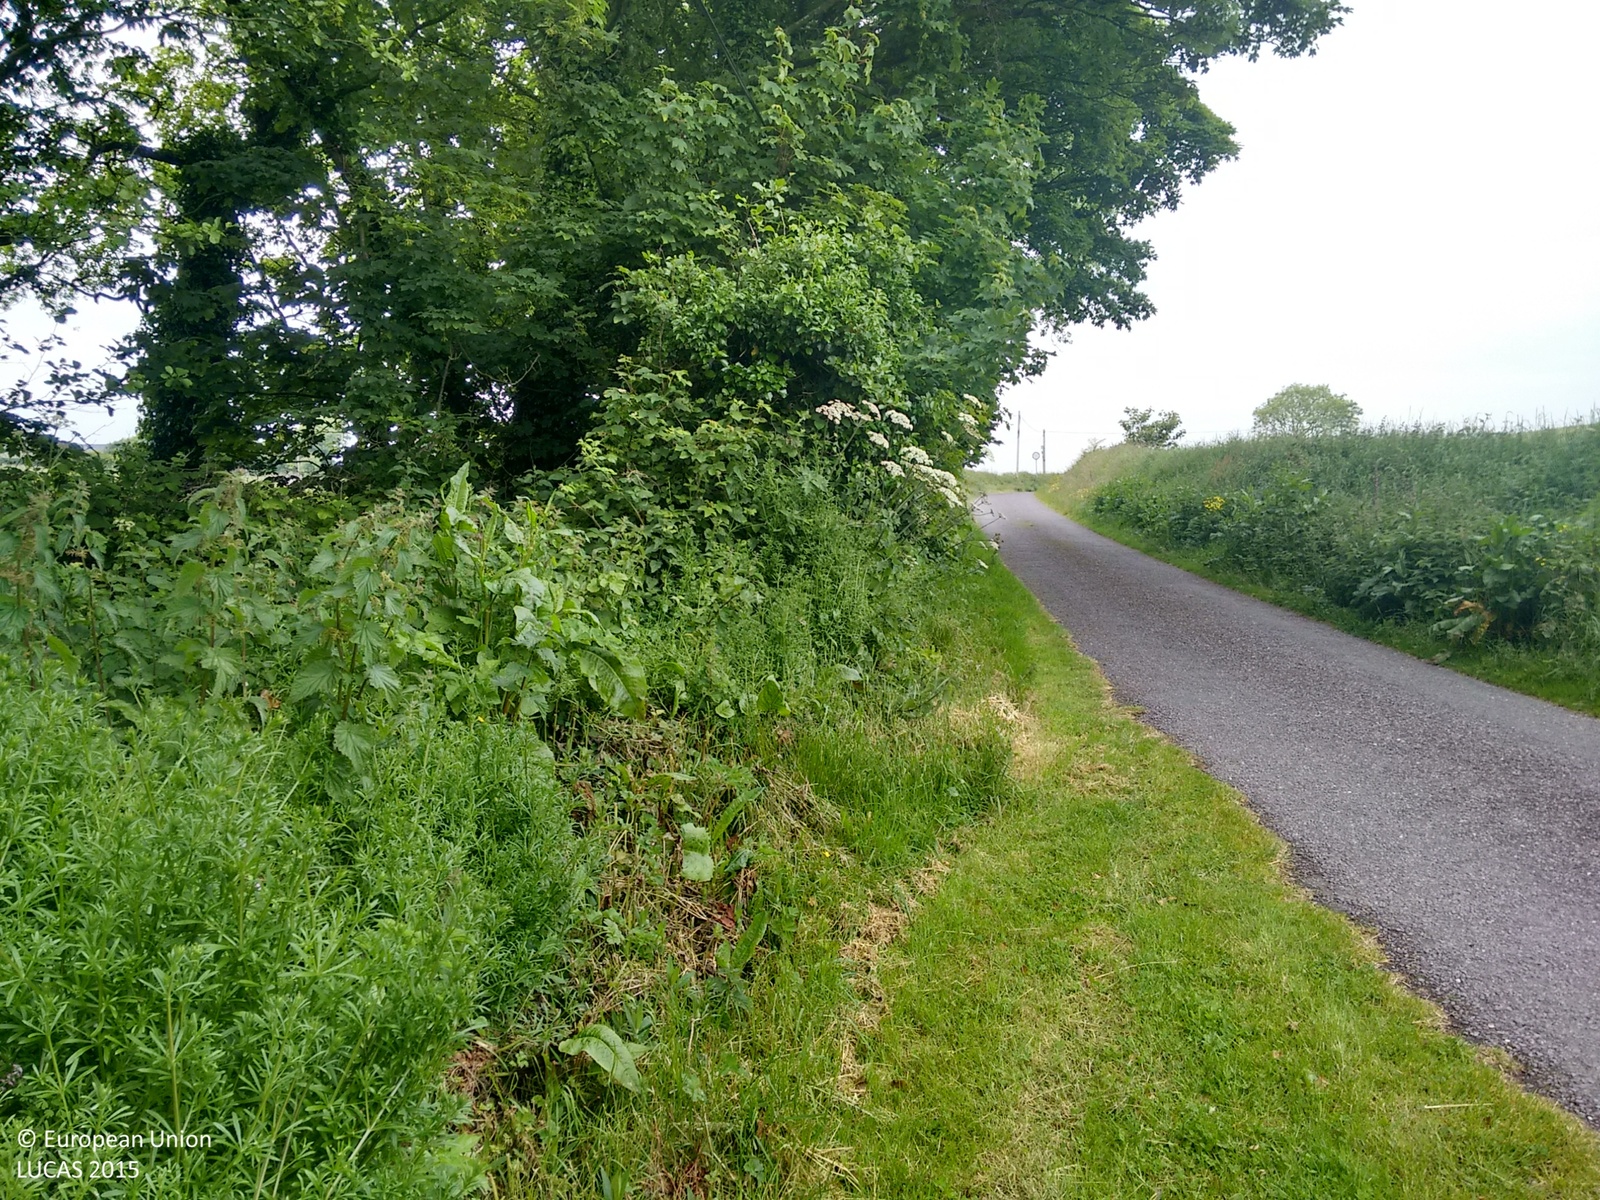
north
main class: Woodland
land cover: Broadleaved woodland
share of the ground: > 75 %
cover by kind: broadleaved forest trees 100 %
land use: Semi-natural and natural areas not in use
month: June
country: IE
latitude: 51.6281
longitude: -8.7071
